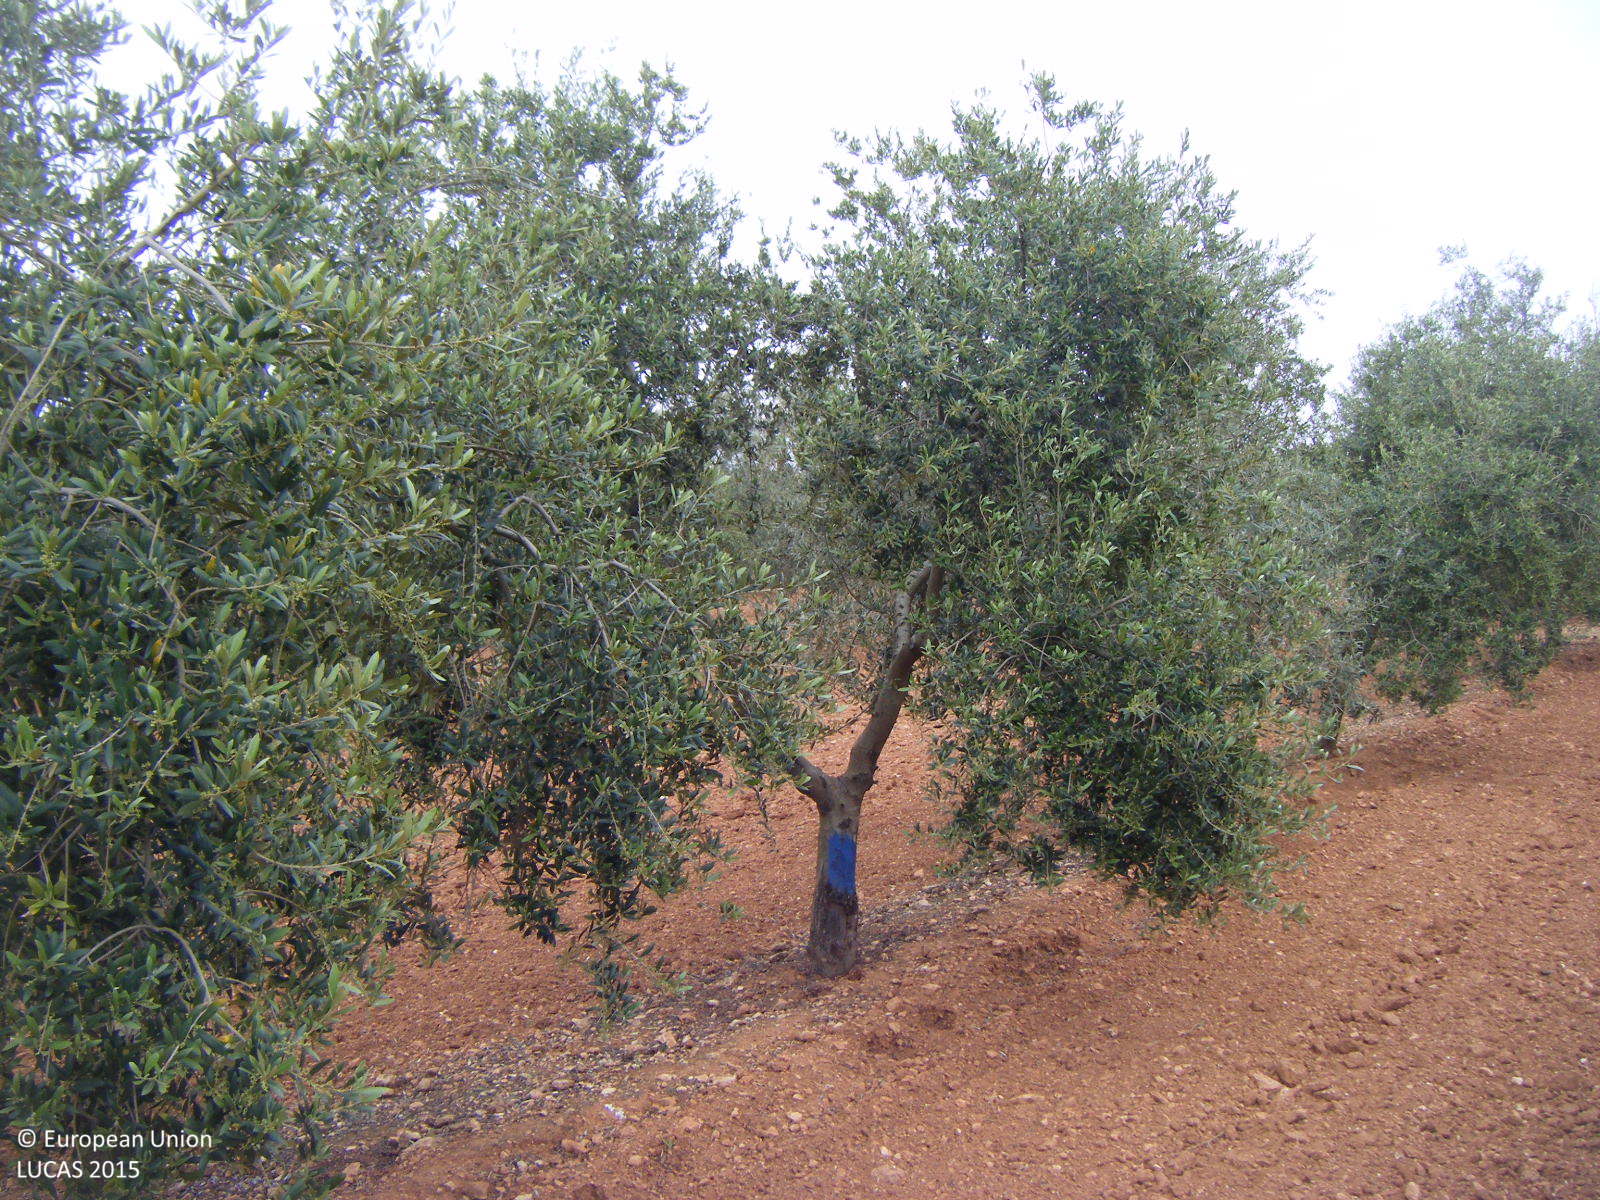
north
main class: Cropland
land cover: Olive groves
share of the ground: 25 - 50 %
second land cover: Other bare soil
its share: > 75 %
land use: Agriculture (excluding fallow land and kitchen gardens)
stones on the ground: < 10 %
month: April
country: ES
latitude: 37.1907
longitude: -4.7938
